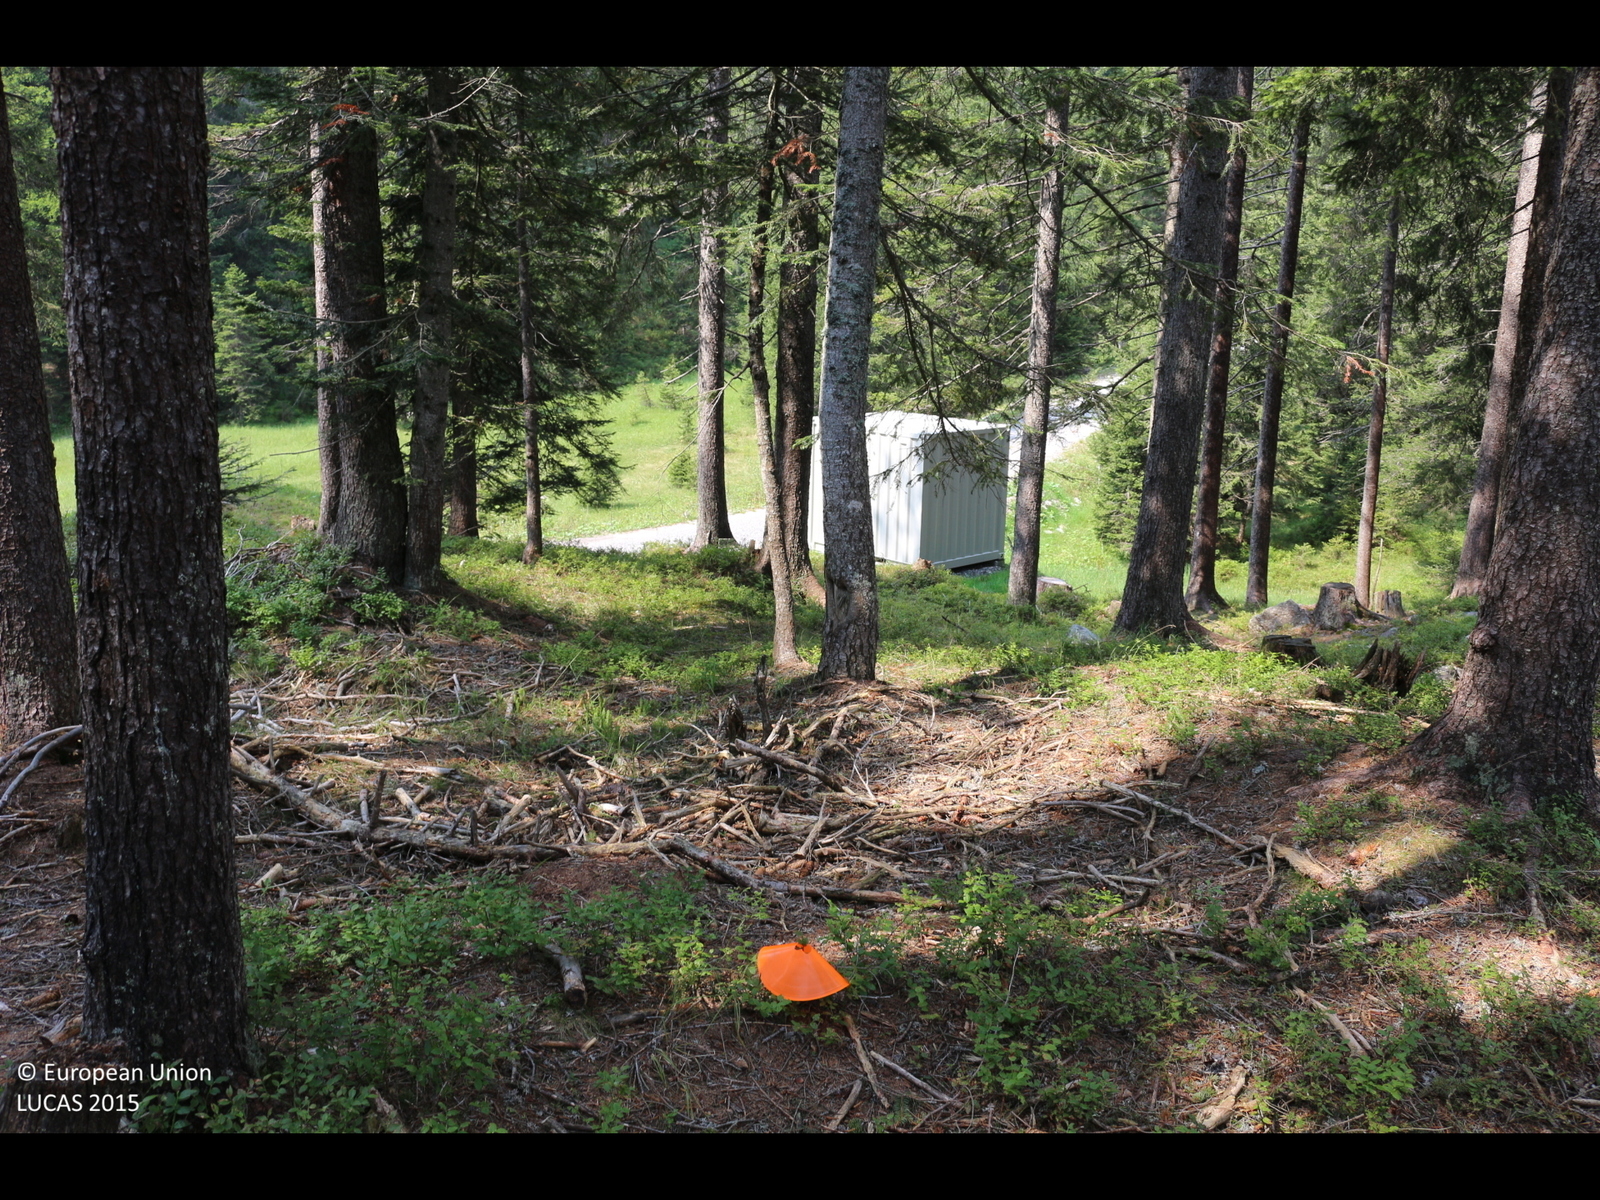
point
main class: Woodland
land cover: Spruce dominated coniferous woodland
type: alpine coniferous forest
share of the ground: > 75 %
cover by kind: coniferous forest trees 80 %, shrubs 15 %, unconsolidated bare surface 5 %
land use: Forestry
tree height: > 5 m
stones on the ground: 10 - 25 %
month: August
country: AT
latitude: 46.5716
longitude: 13.2720
